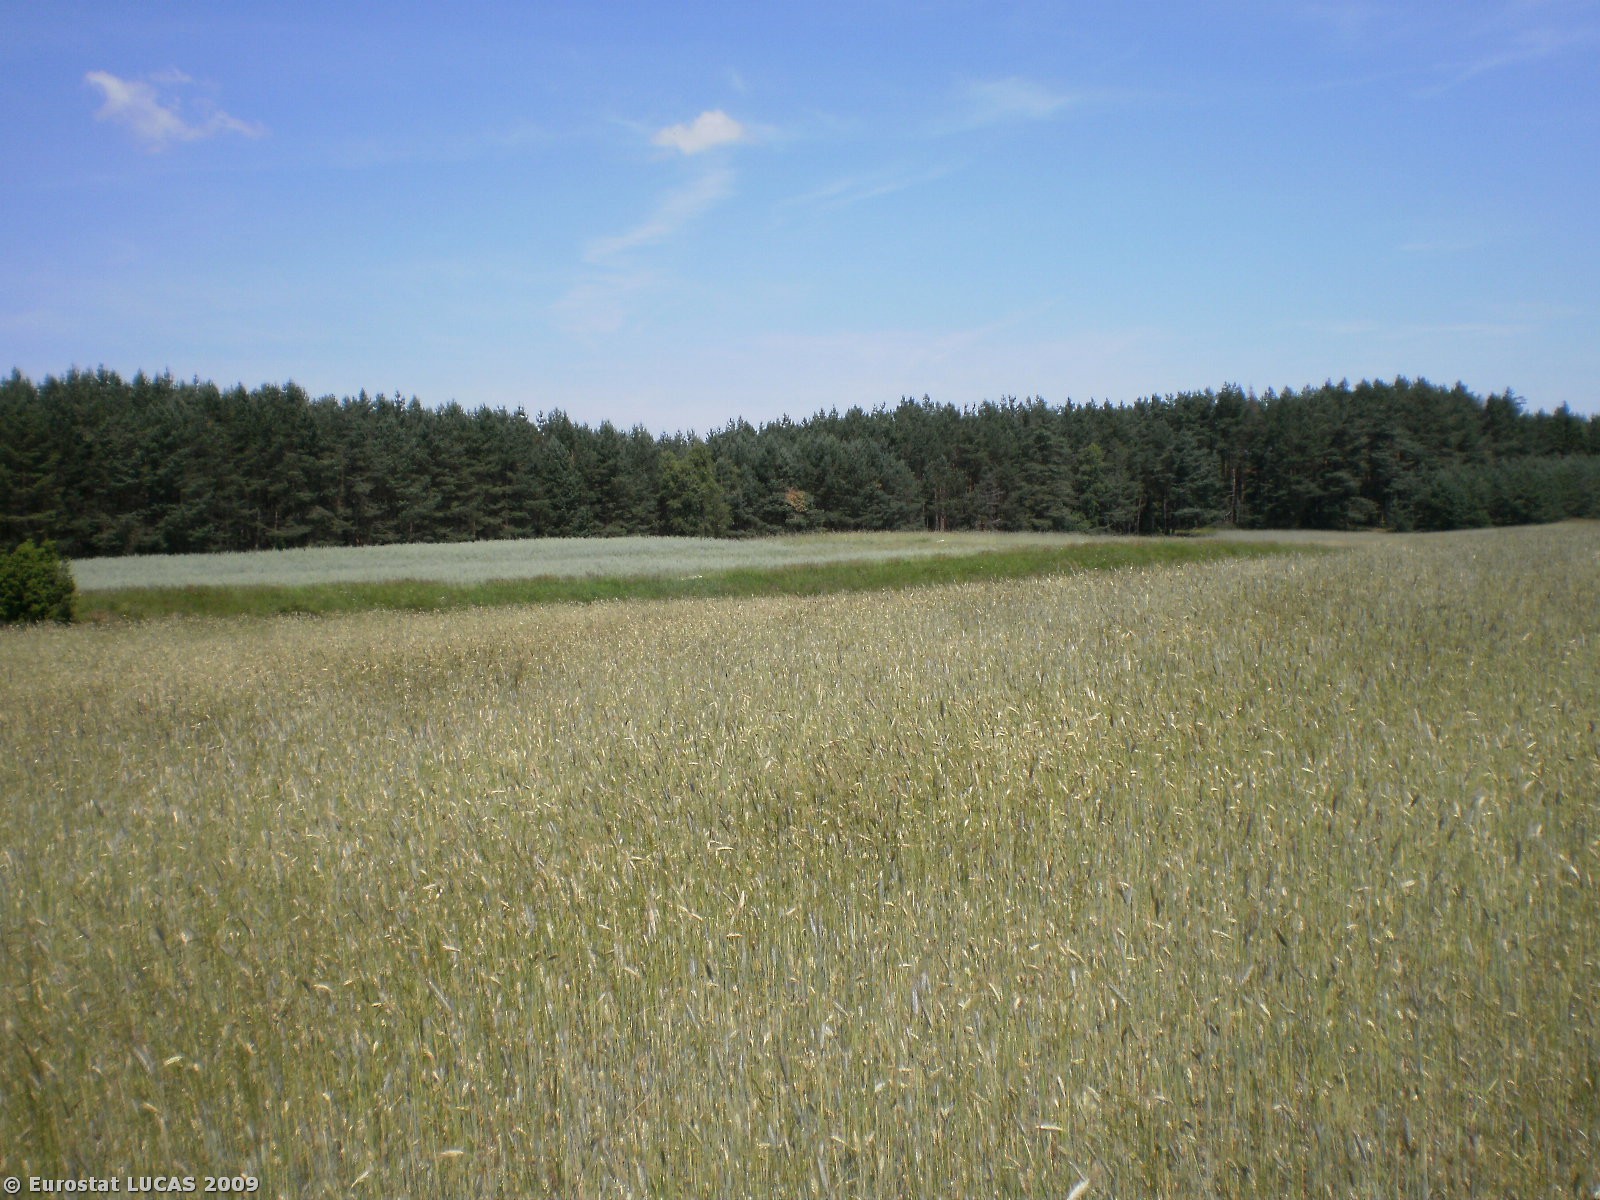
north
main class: Cropland
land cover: Rye
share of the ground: > 75 %
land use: Agriculture (excluding fallow land and kitchen gardens)
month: July
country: PL
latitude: 54.1969
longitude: 17.8148
